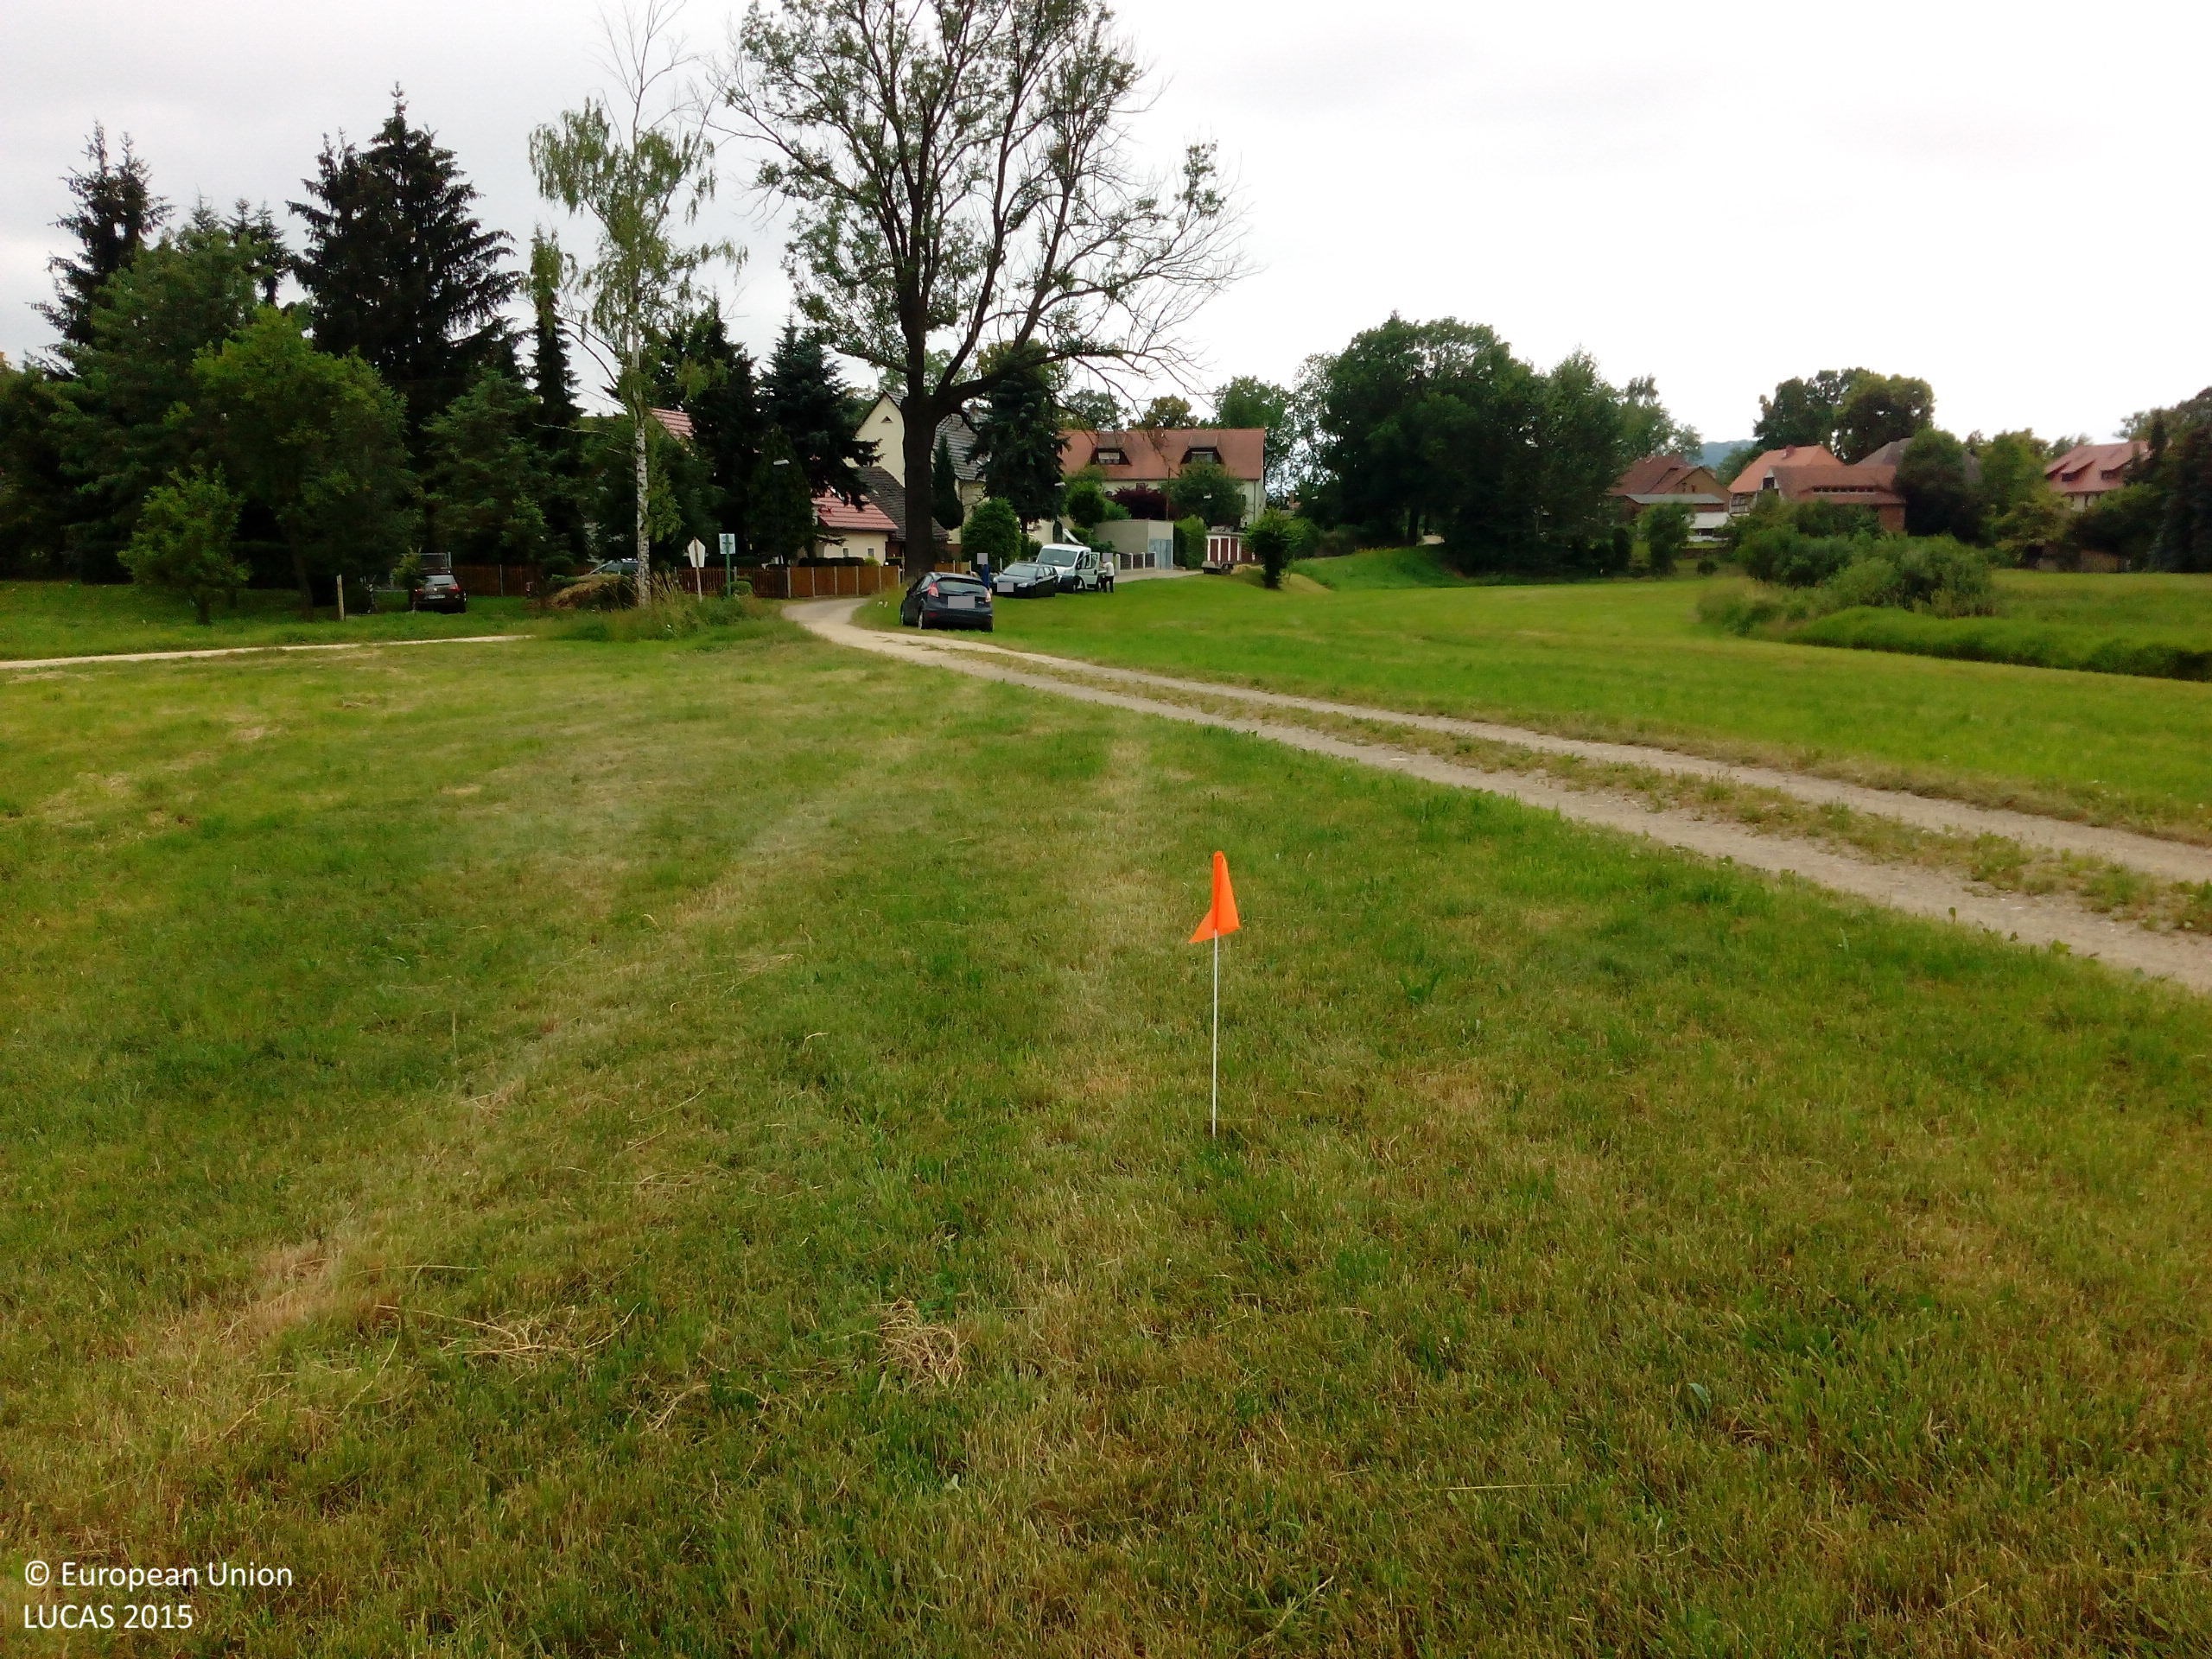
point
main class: Grassland
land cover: Grassland without tree/shrub cover
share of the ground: > 75 %
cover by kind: herbaceous plants 100 %
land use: Agriculture (excluding fallow land and kitchen gardens)
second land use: Amenities, museums, leisure
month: July
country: DE
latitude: 51.1199
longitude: 14.9889
